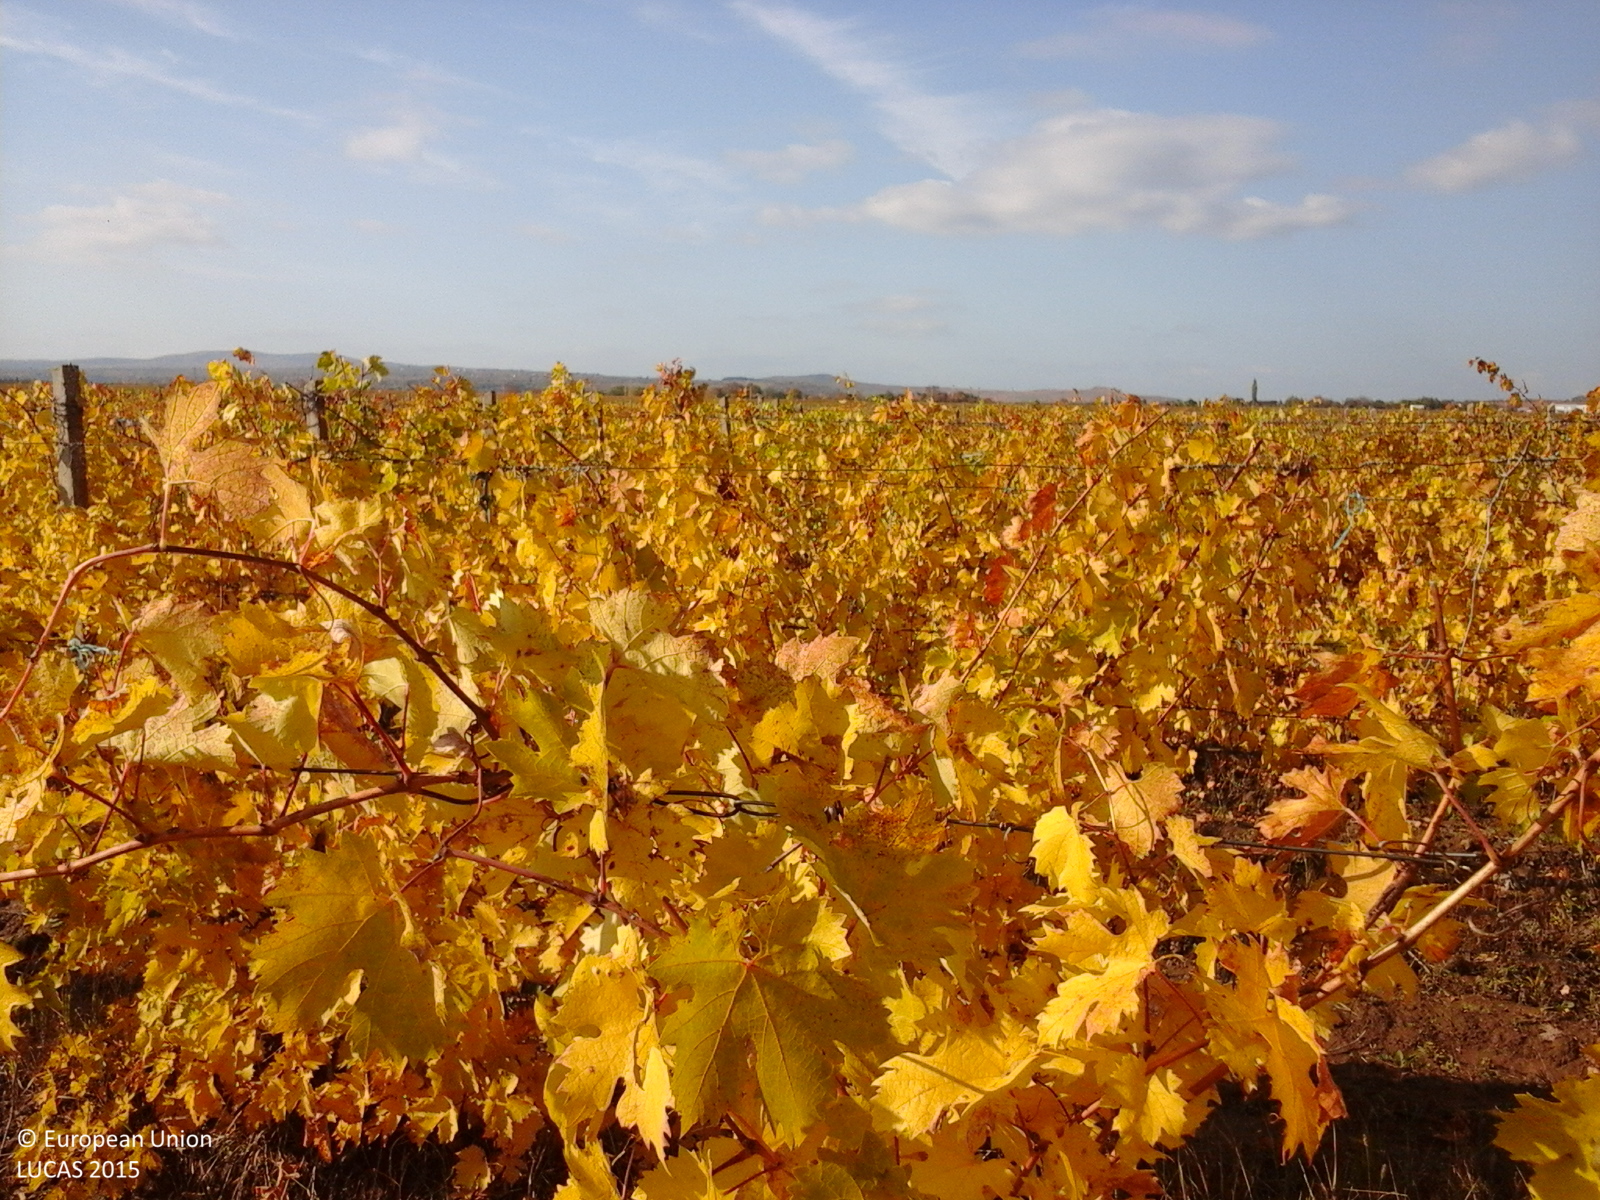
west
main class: Cropland
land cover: Vineyards
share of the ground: > 75 %
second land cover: Other bare soil
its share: > 75 %
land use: Agriculture (excluding fallow land and kitchen gardens)
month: October
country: RO
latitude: 45.5690
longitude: 27.0944
